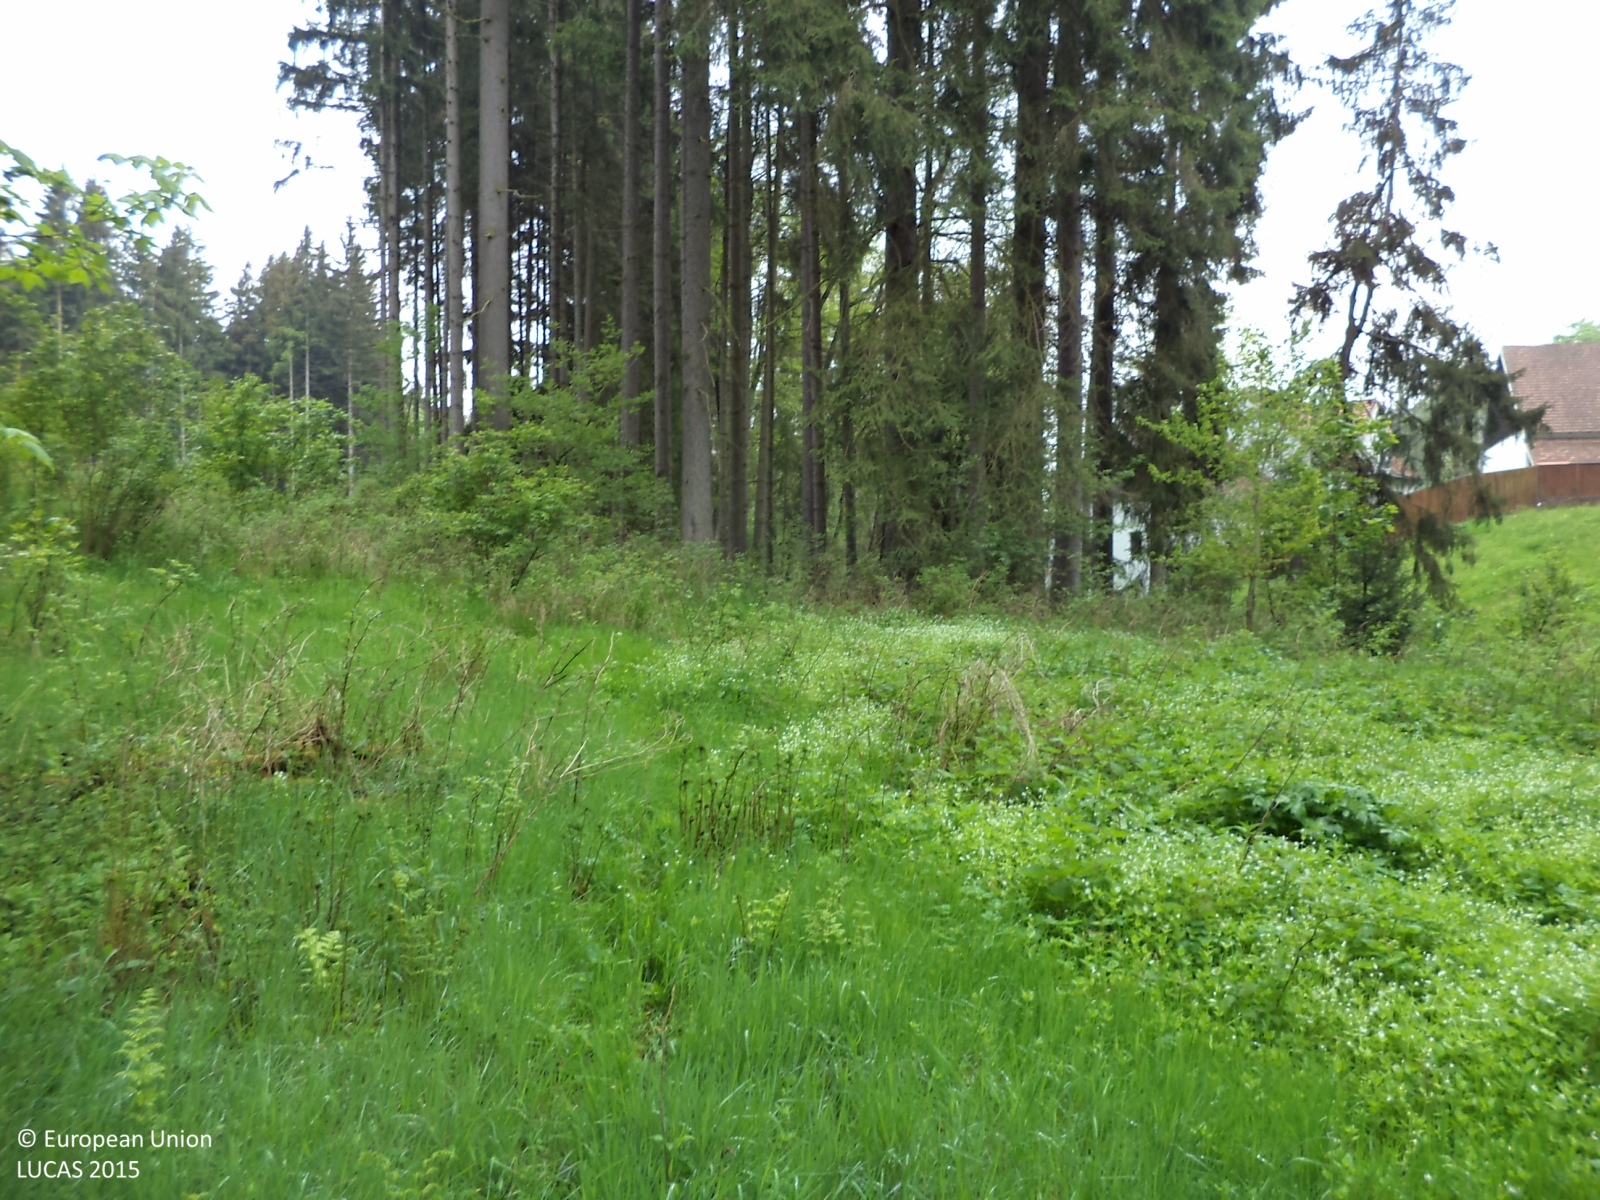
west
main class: Grassland
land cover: Grassland with sparse tree/shrub cover
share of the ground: > 75 %
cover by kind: herbaceous plants 90 %, broadleaved forest trees 5 %, shrubs 5 %
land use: Forestry
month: May
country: CZ
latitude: 49.4831
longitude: 14.9300
